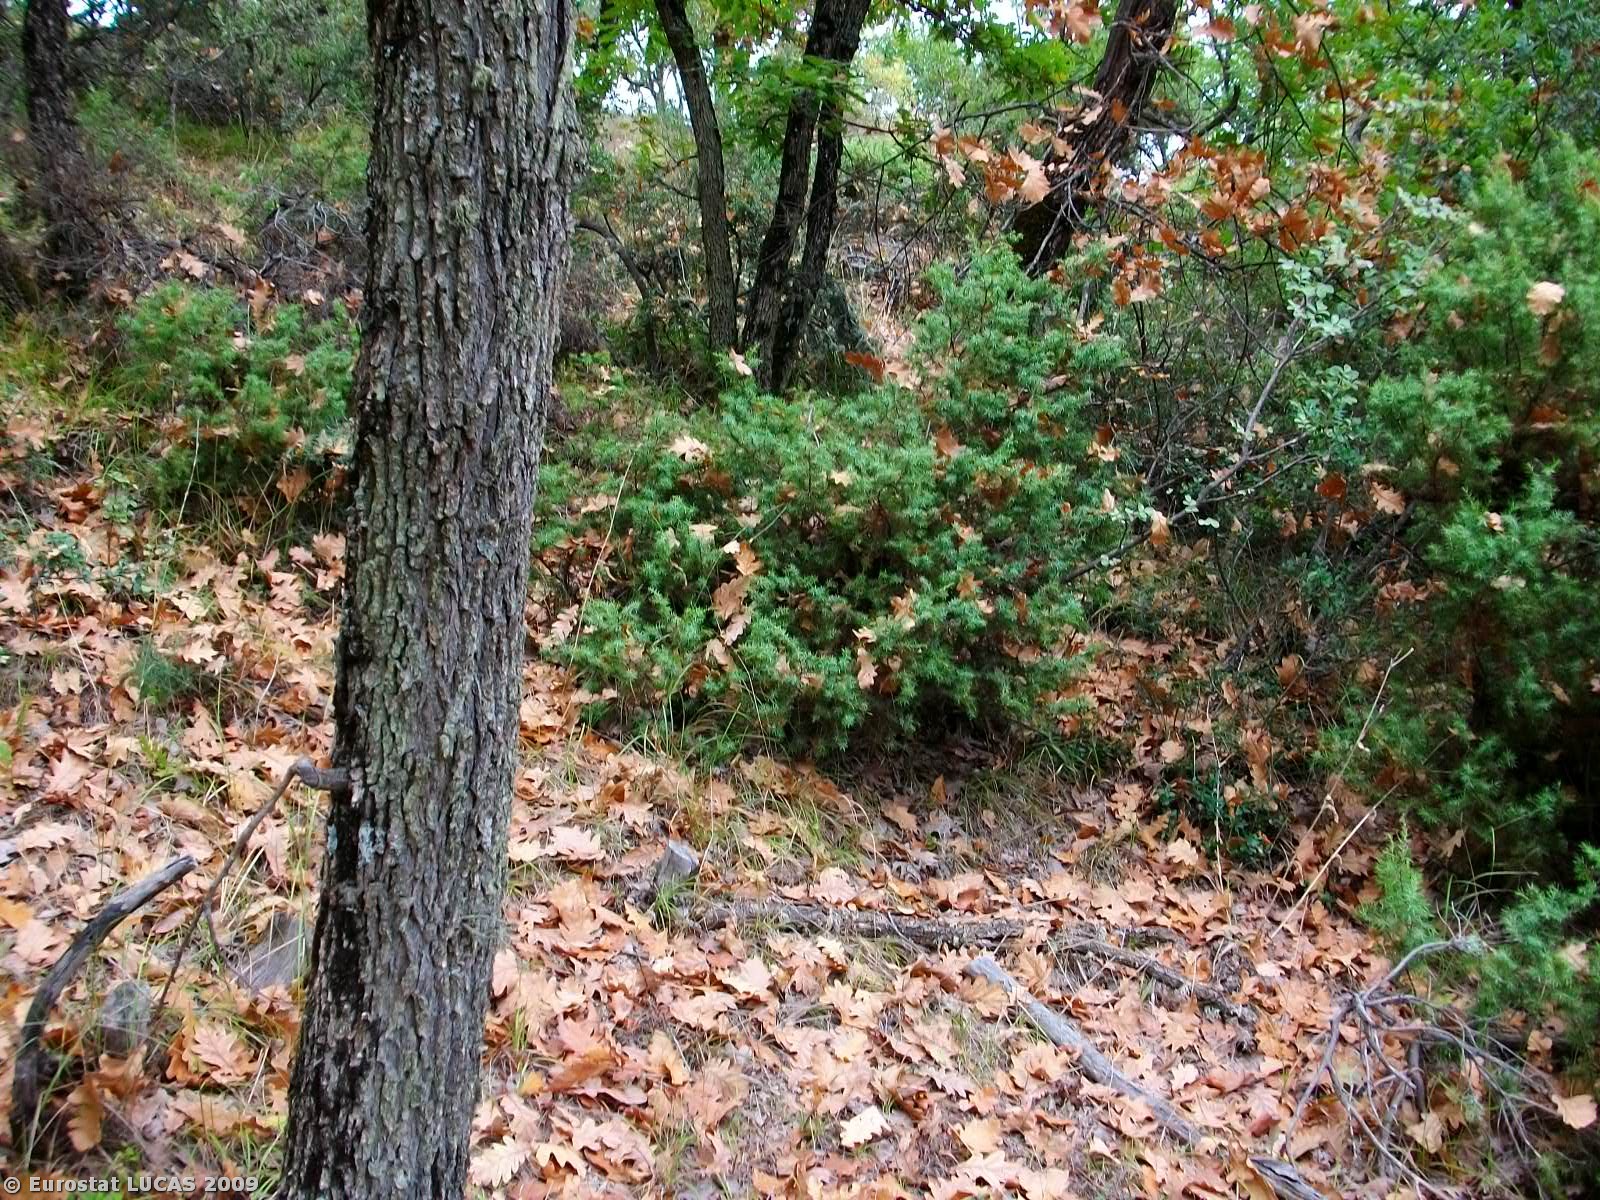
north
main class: Woodland
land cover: Broadleaved woodland
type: thermophilous deciduous forest
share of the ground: > 75 %
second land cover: Grassland with sparse tree/shrub cover
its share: 50 - 75 %
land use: Forestry
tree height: > 5 m
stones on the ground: 10 - 25 %
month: September
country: GR
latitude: 41.2691
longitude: 26.2935
